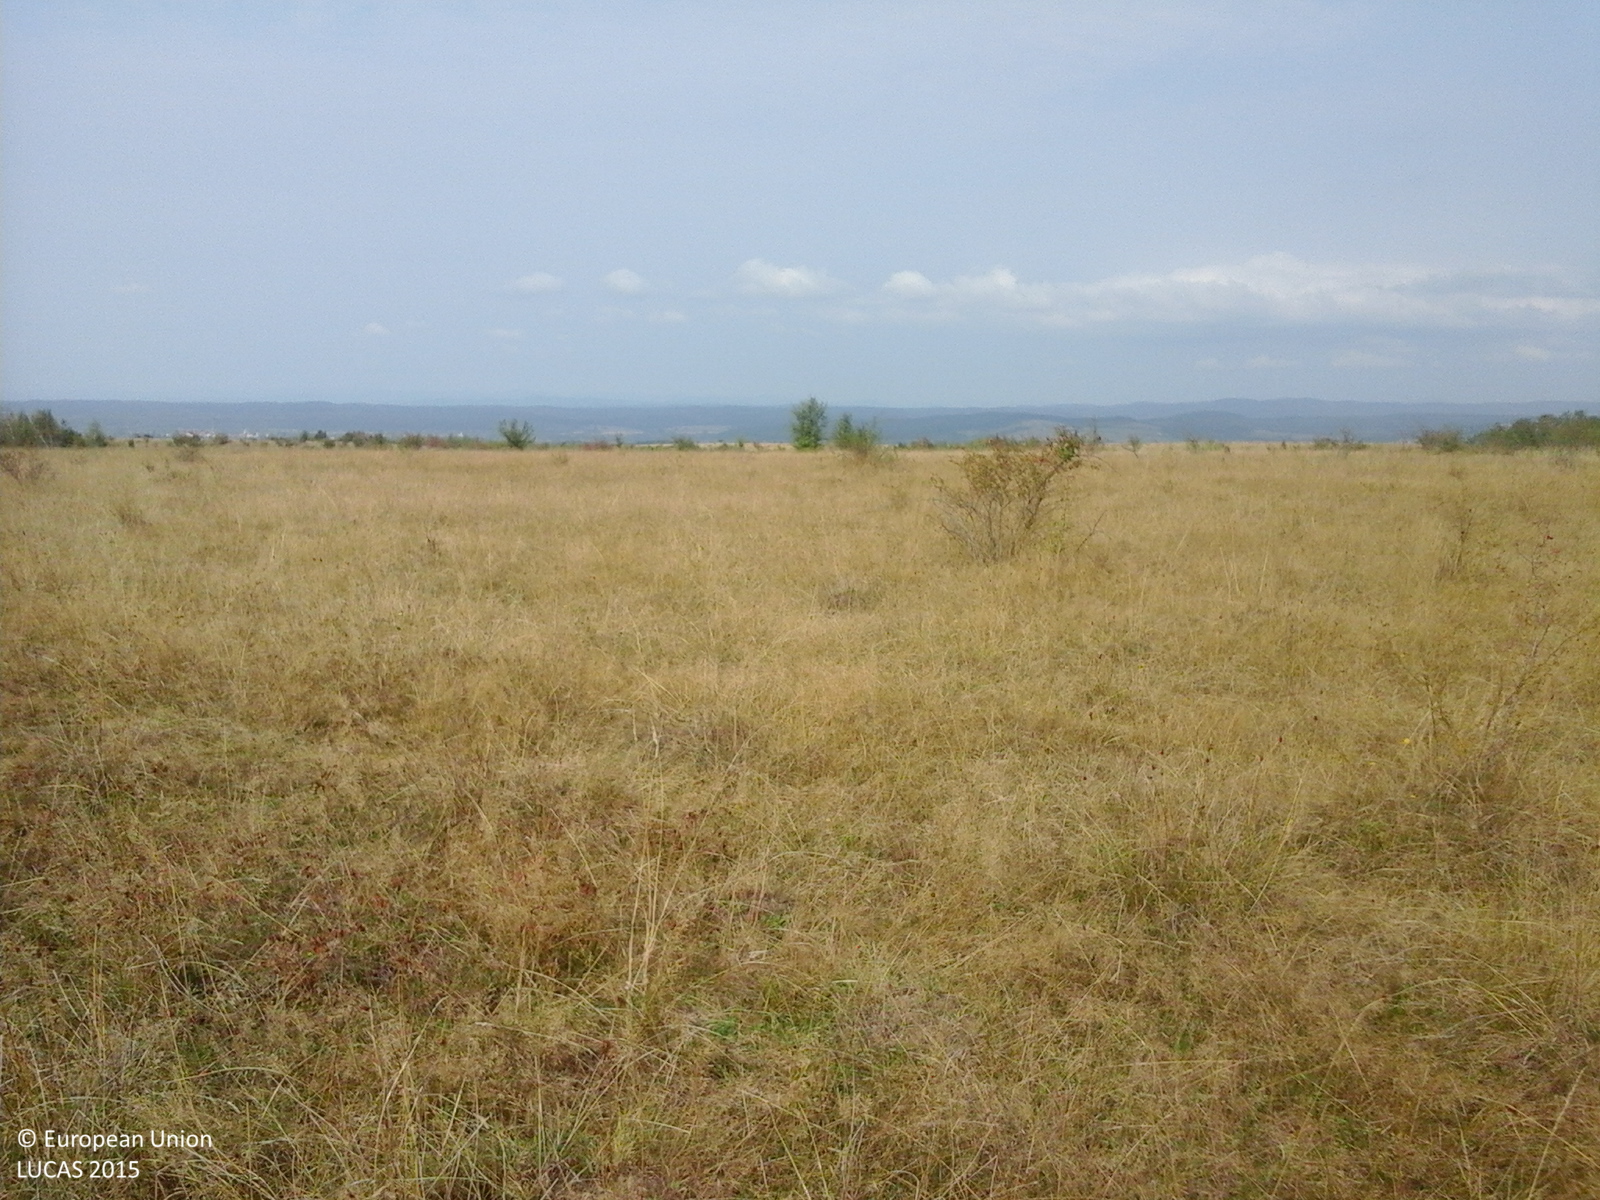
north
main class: Grassland
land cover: Grassland with sparse tree/shrub cover
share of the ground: > 75 %
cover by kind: herbaceous plants 85 %, shrubs 10 %, broadleaved forest trees 5 %
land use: Agriculture (excluding fallow land and kitchen gardens)
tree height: < 5 m
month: September
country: RO
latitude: 45.8044
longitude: 22.2809
